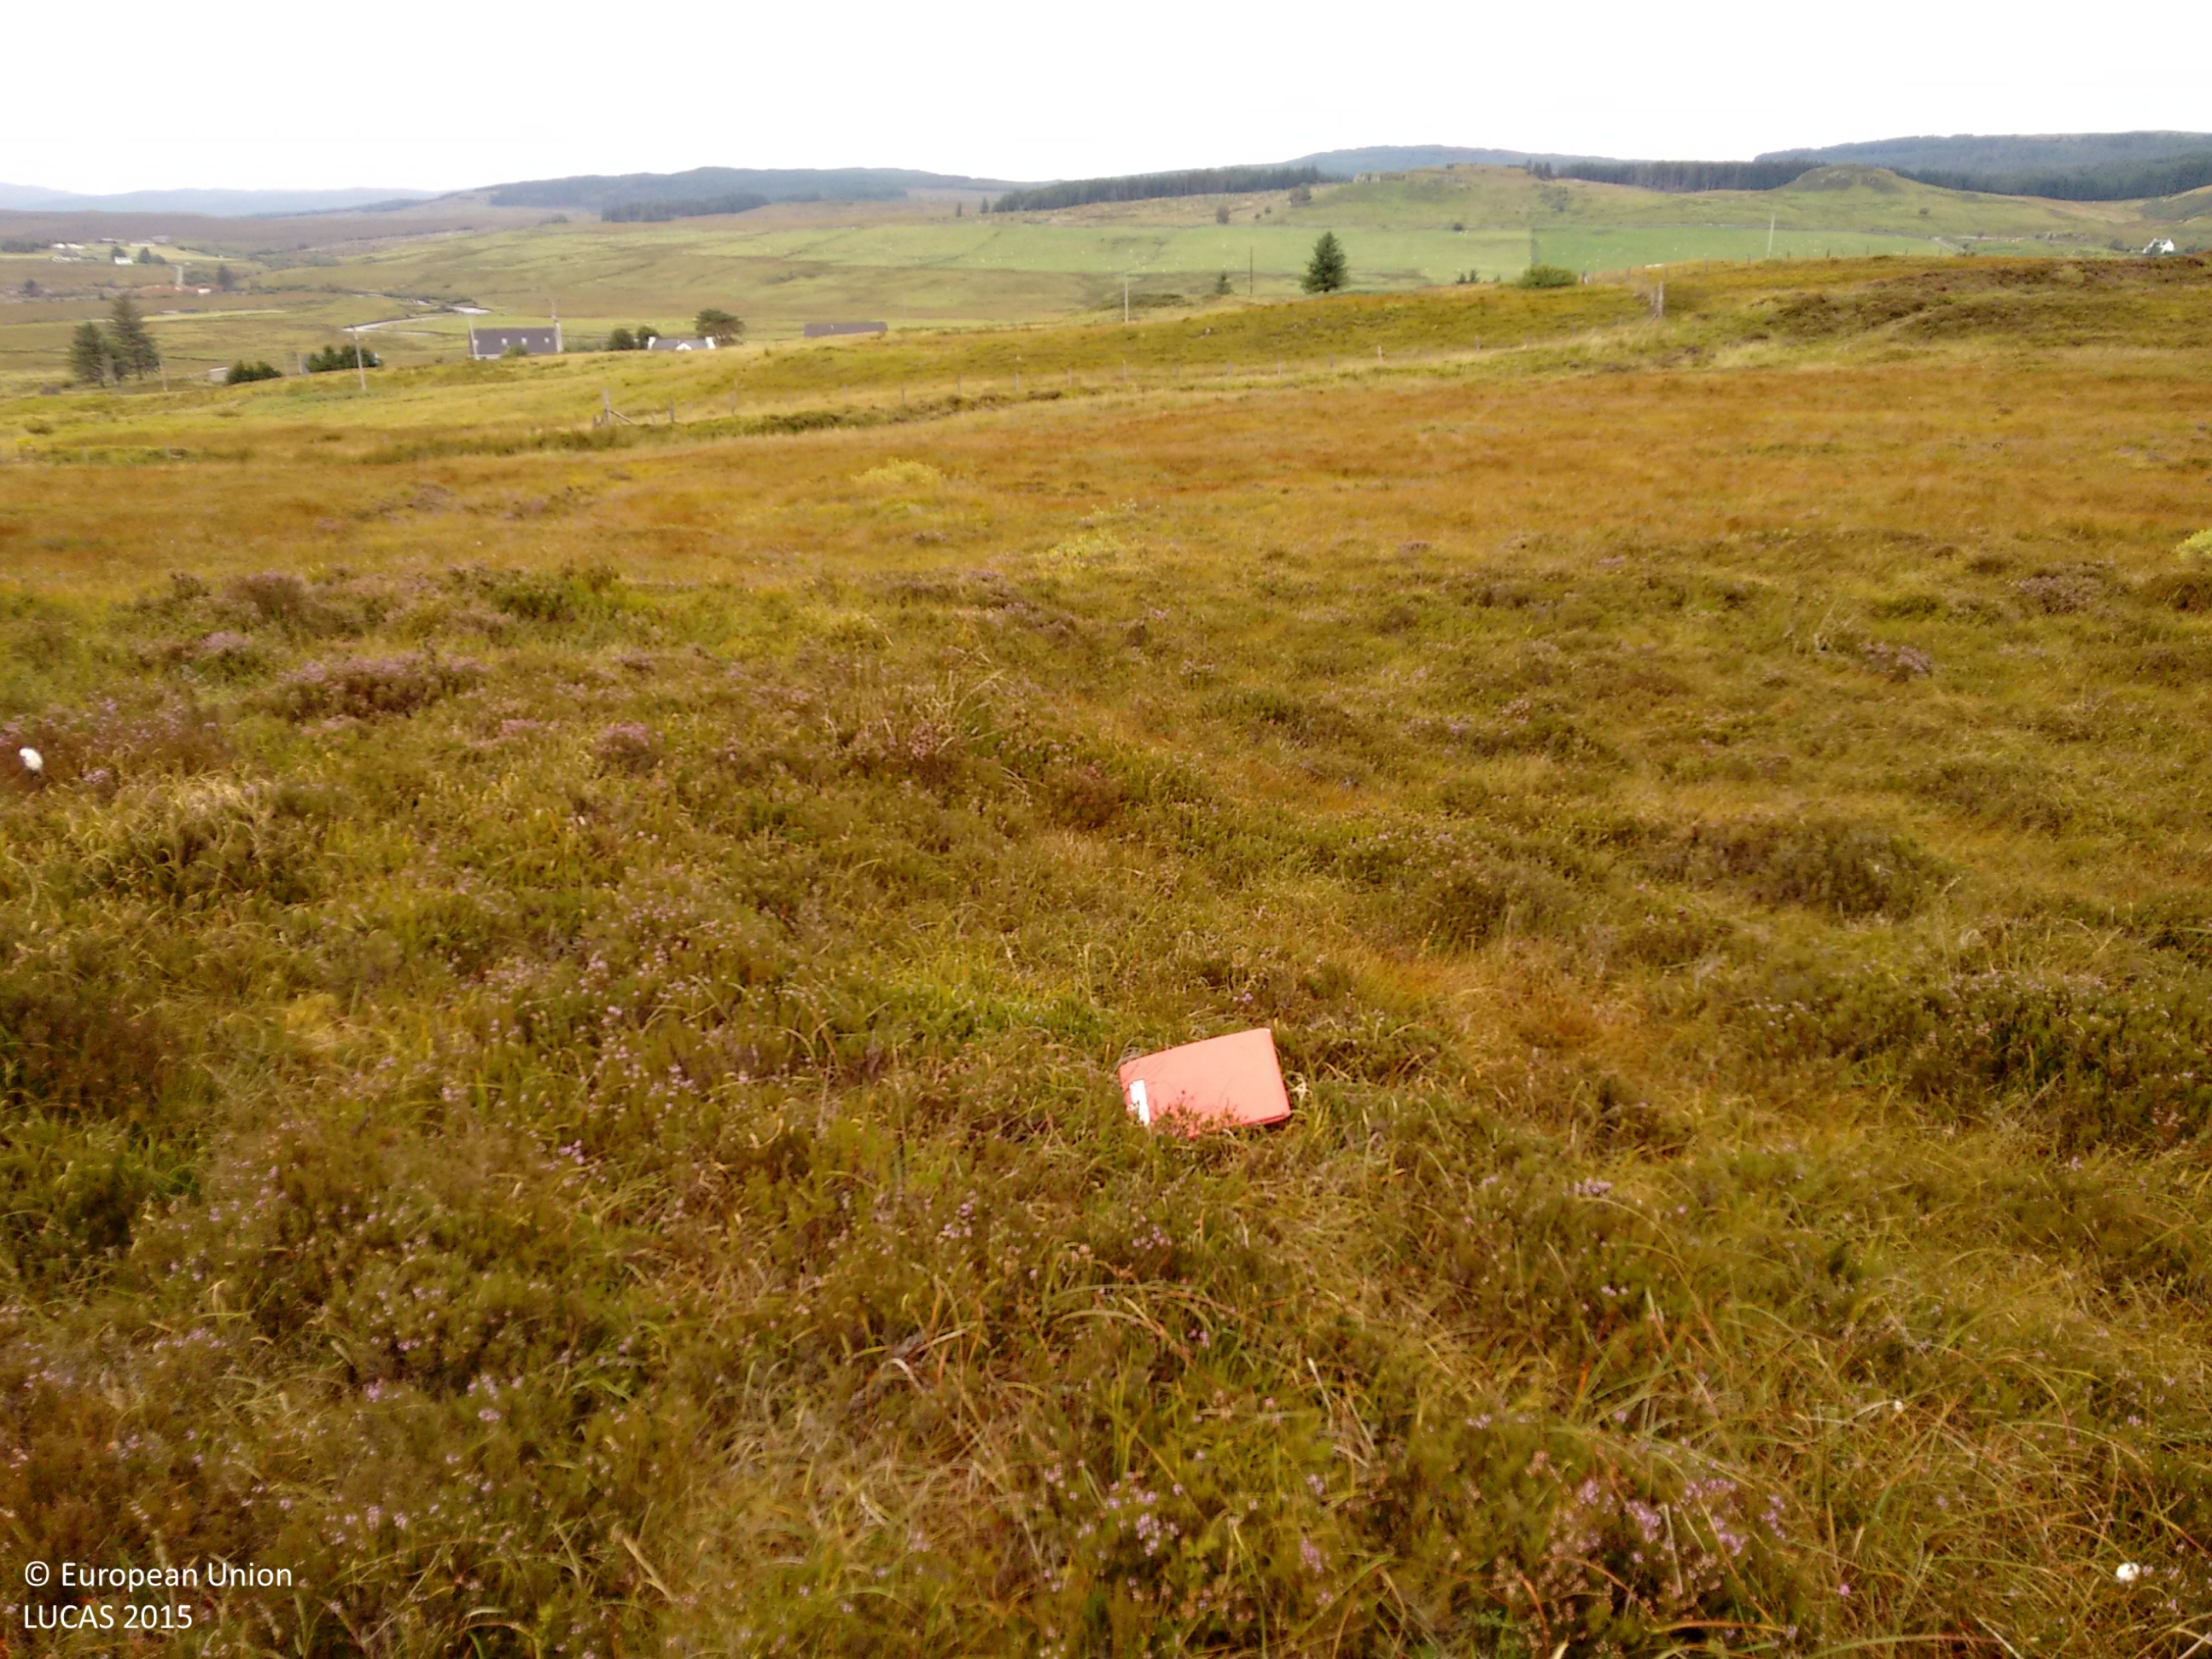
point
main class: Shrubland
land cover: Shrubland without tree cover
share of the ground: > 75 %
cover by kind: shrubs 80 %, herbaceous plants 20 %
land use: Agriculture (excluding fallow land and kitchen gardens)
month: September
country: GB
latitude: 57.4549
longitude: -6.2867
